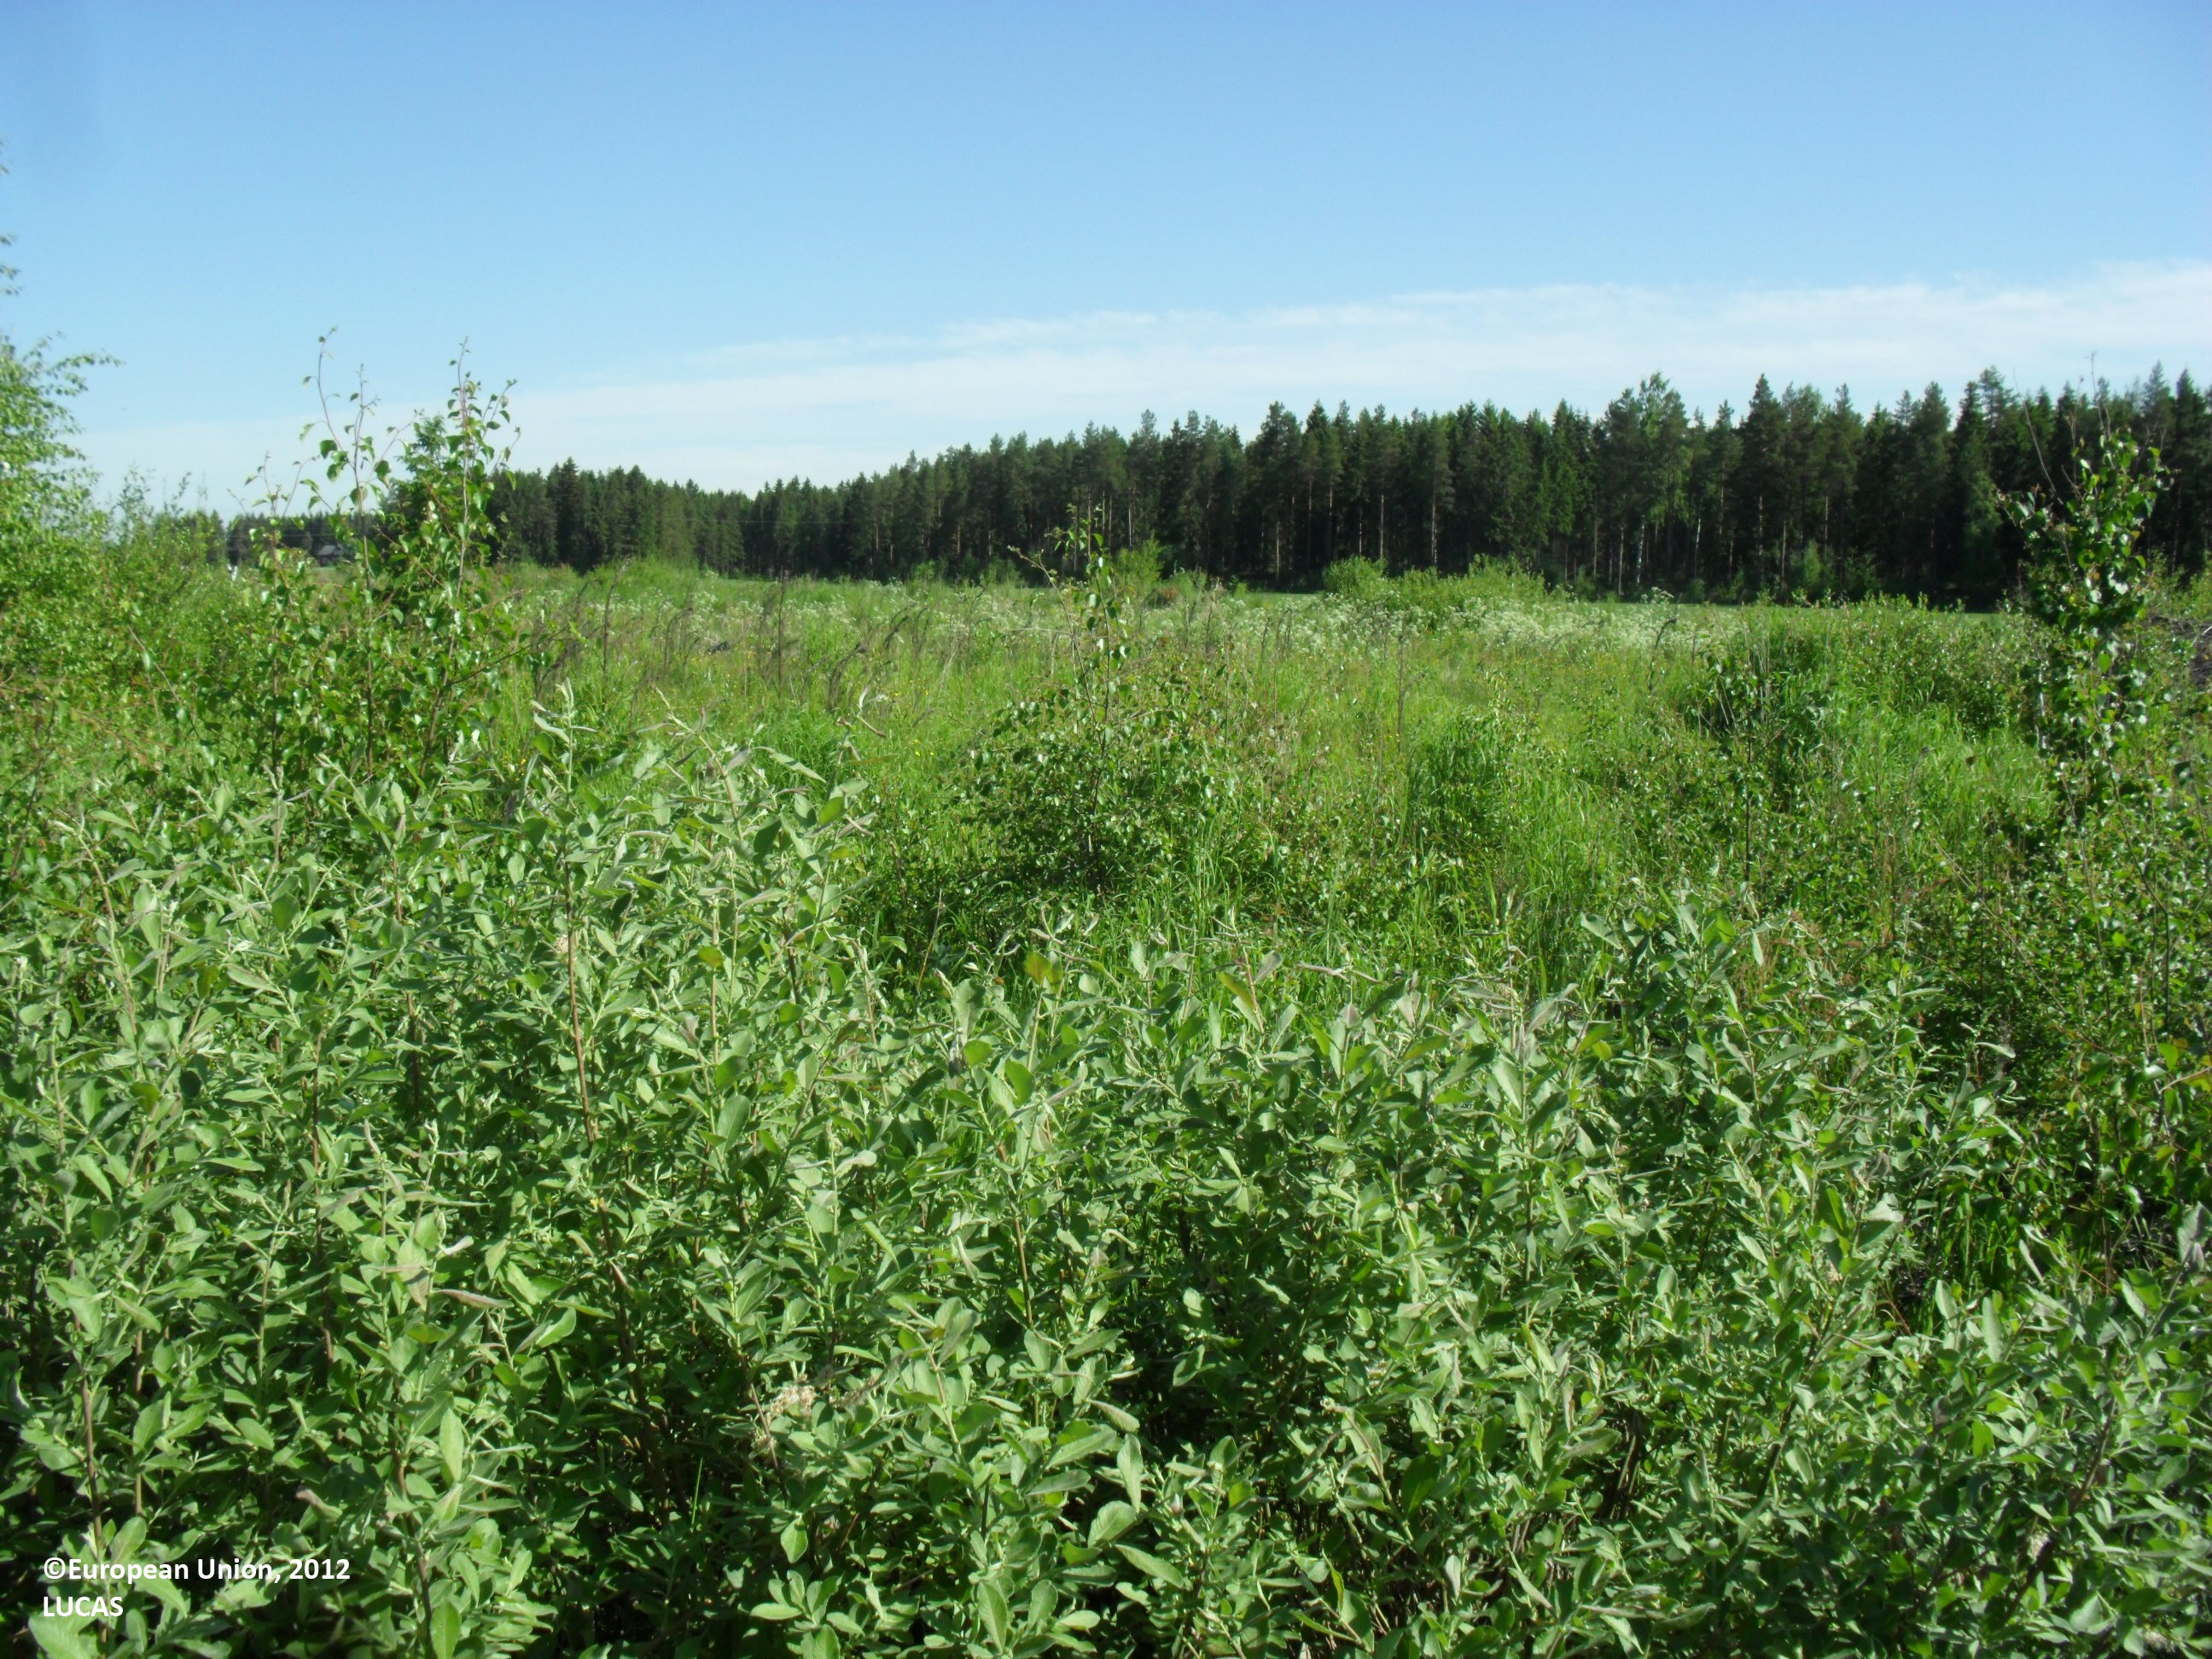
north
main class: Woodland
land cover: Other mixed woodland
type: boreal forest
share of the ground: 10 - 25 %
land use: Forestry
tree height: < 5 m
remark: Clear cut
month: June
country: FI
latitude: 62.9542
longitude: 23.0907
